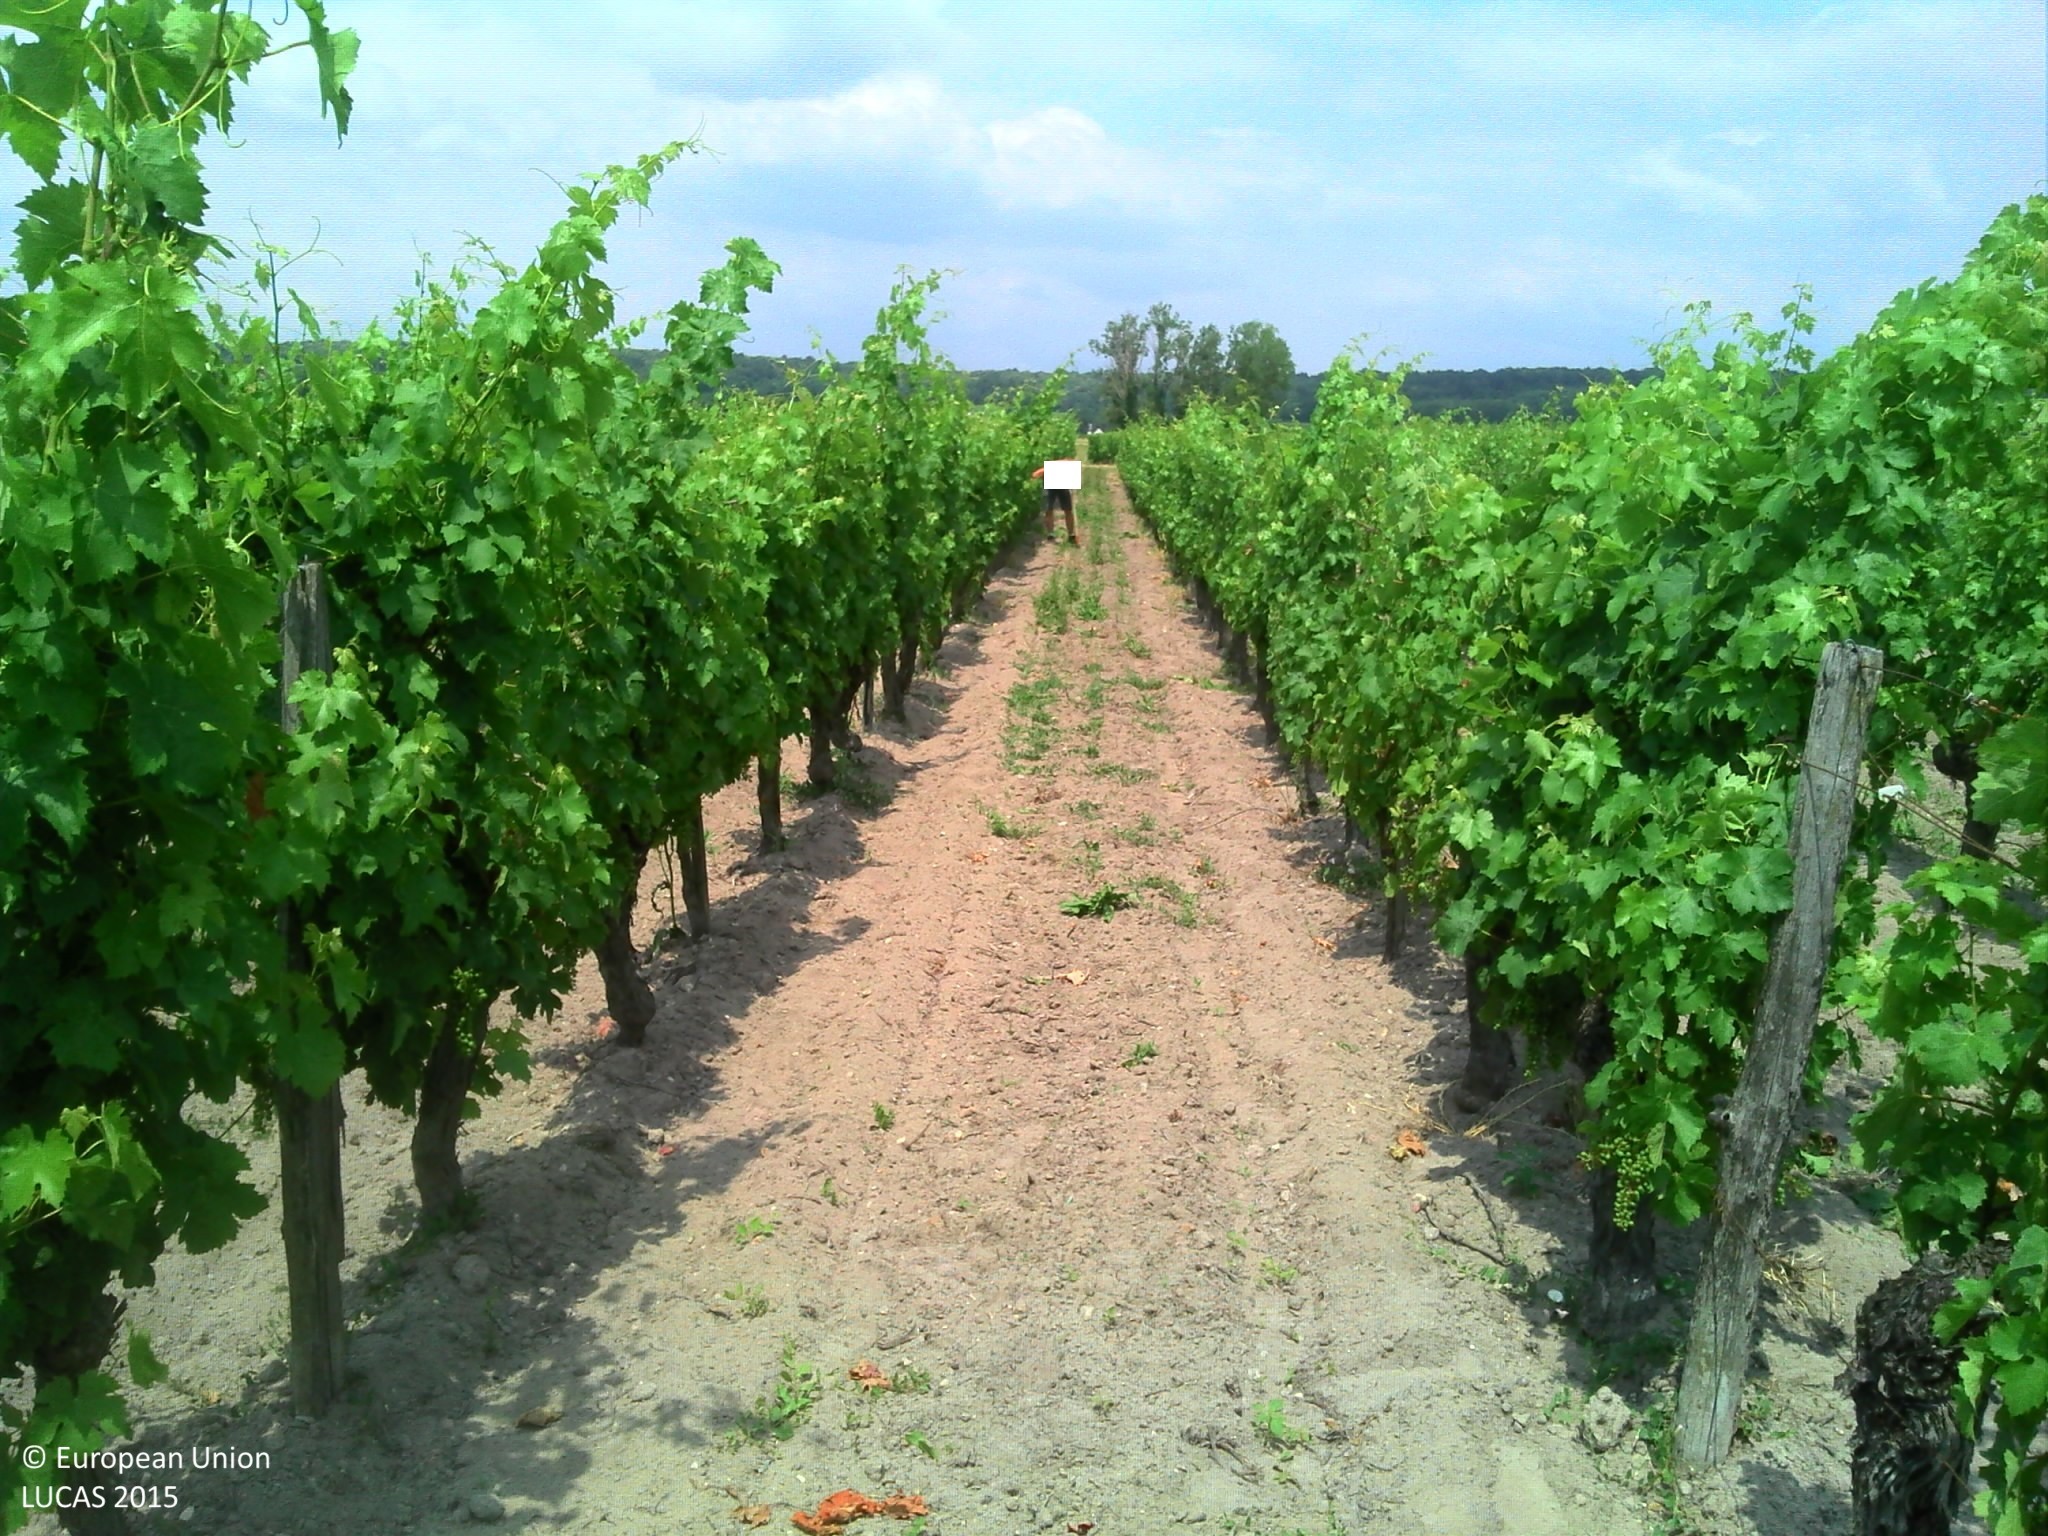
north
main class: Cropland
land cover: Vineyards
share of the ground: 25 - 50 %
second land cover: Other bare soil
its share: > 75 %
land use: Agriculture (excluding fallow land and kitchen gardens)
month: July
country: FR
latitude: 47.2897
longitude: 0.1252
